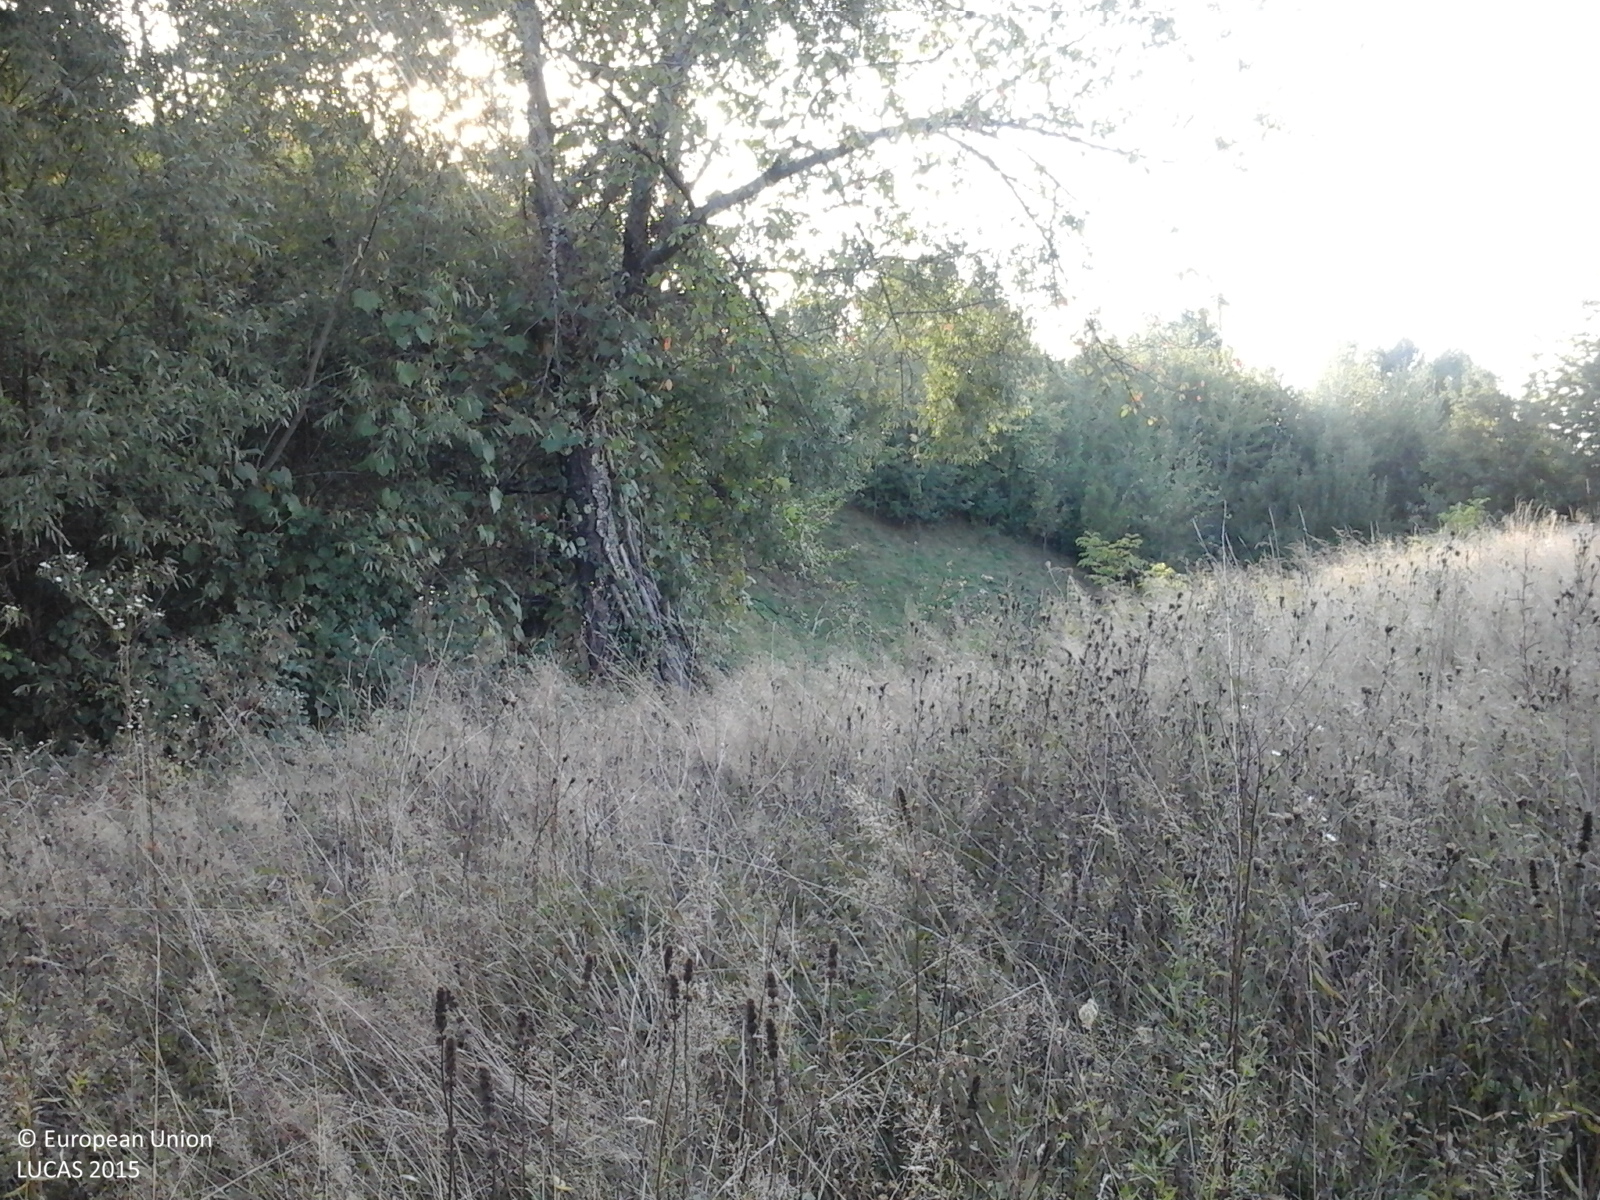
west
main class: Grassland
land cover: Grassland without tree/shrub cover
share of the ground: > 75 %
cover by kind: herbaceous plants 100 %
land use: Agriculture (excluding fallow land and kitchen gardens)
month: September
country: RO
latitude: 46.7322
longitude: 22.4444
